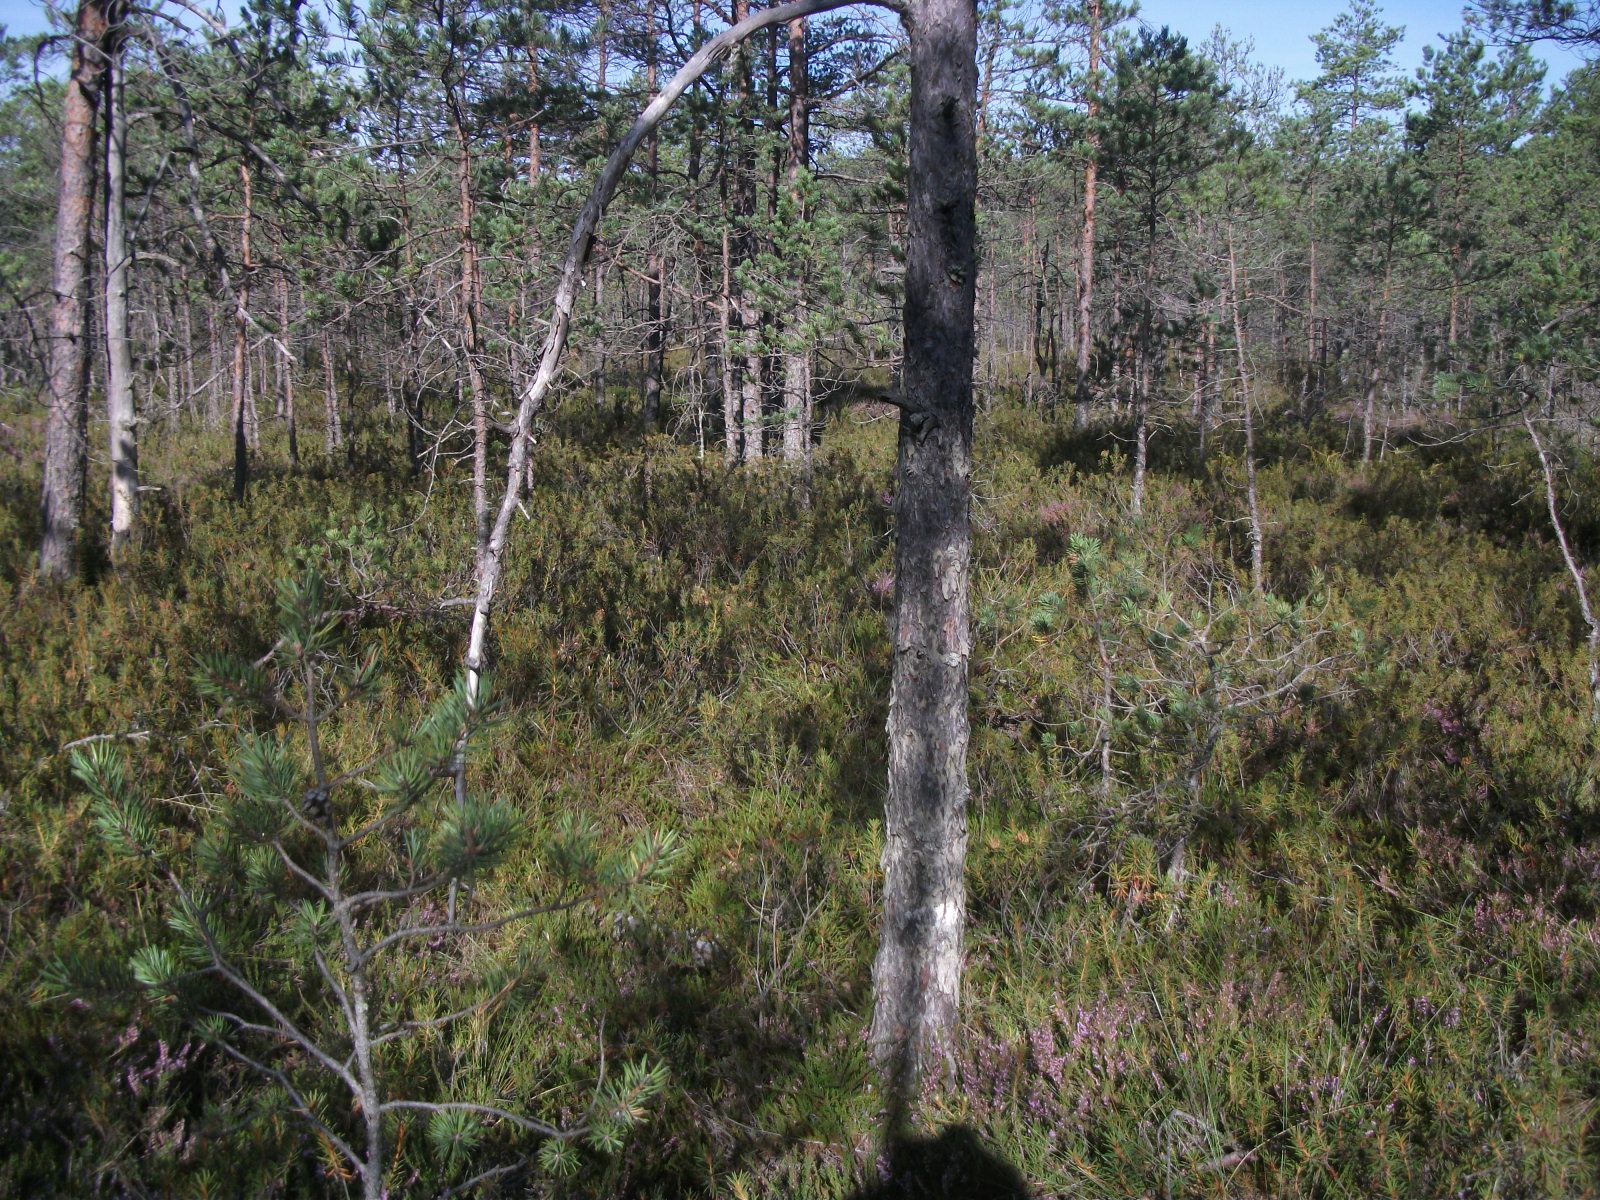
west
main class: Woodland
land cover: Pine dominated coniferous woodland
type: hemiboreal forest and nemoral coniferous forest and mixed broadleaved-coniferous forest
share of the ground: 50 - 75 %
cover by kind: coniferous forest trees 65 %, lichens and mosses 30 %, herbaceous plants 5 %
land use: Semi-natural and natural areas not in use
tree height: < 5 m
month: August
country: LV
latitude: 56.4204
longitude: 26.1717
